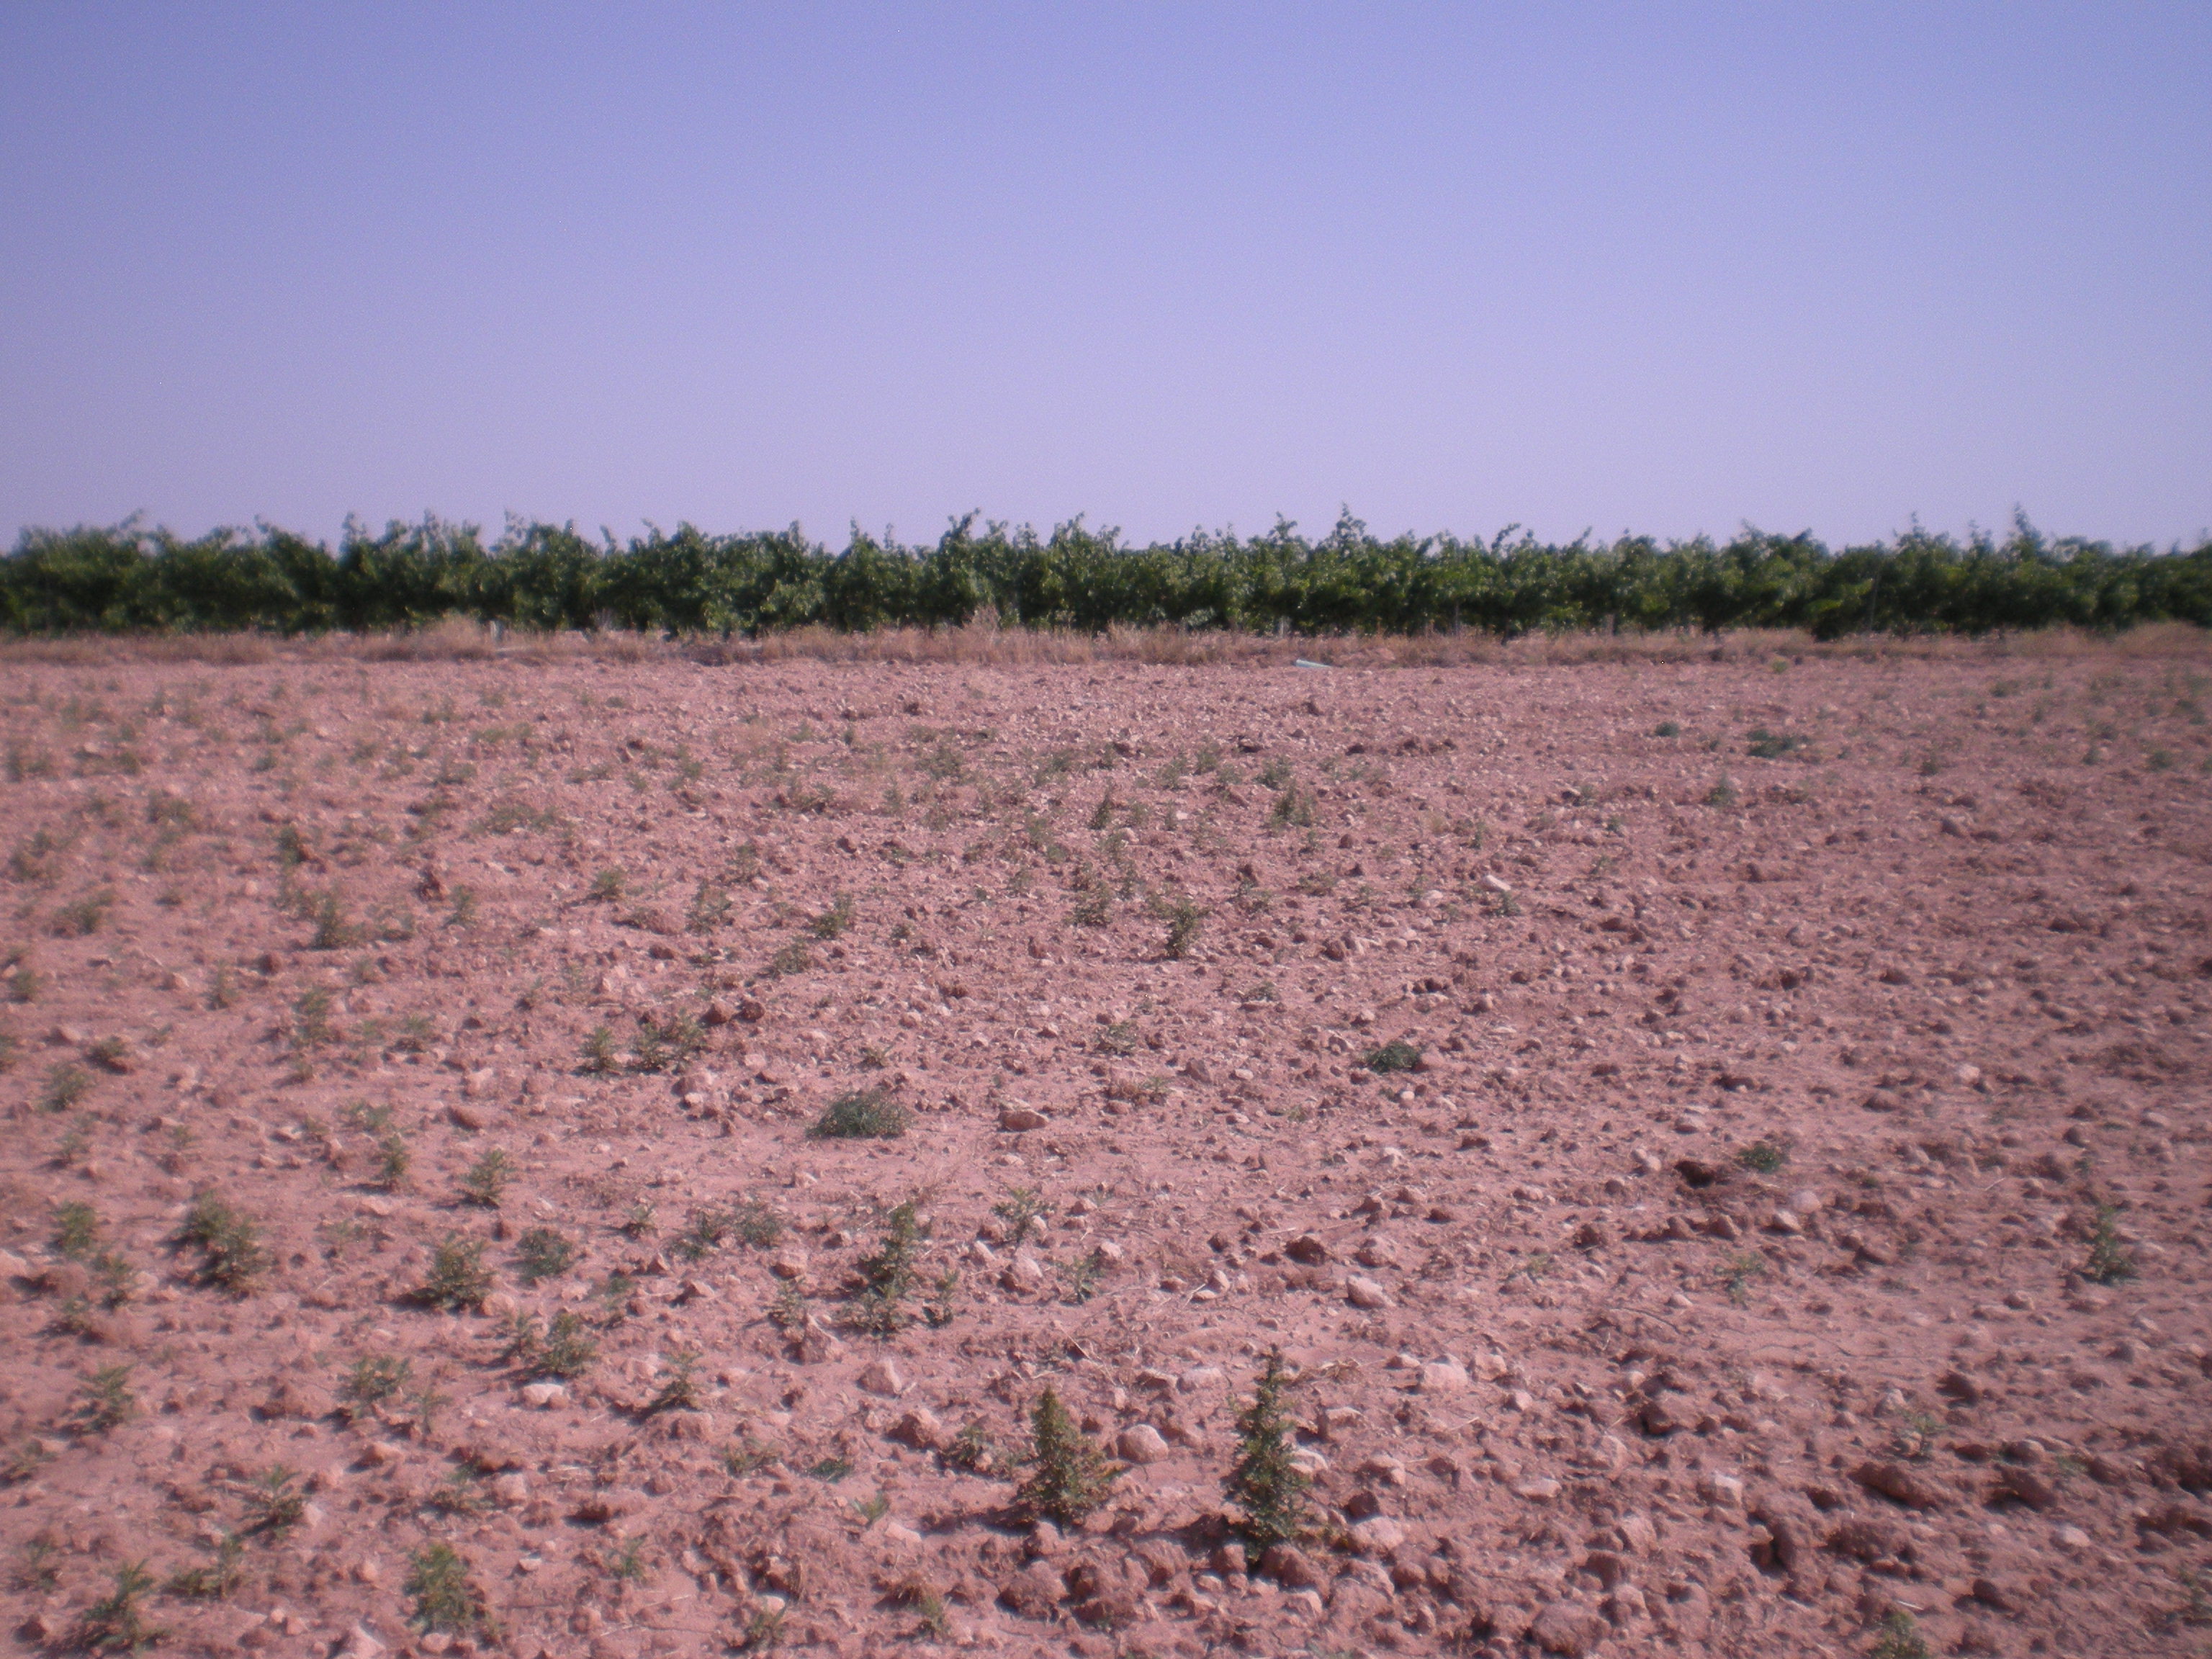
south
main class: Grassland
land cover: Spontaneously vegetated surfaces
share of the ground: 10 - 25 %
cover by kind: unconsolidated bare surface 80 %, herbaceous plants 20 %
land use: Fallow land
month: June
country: ES
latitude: 39.5555
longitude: -3.3239
